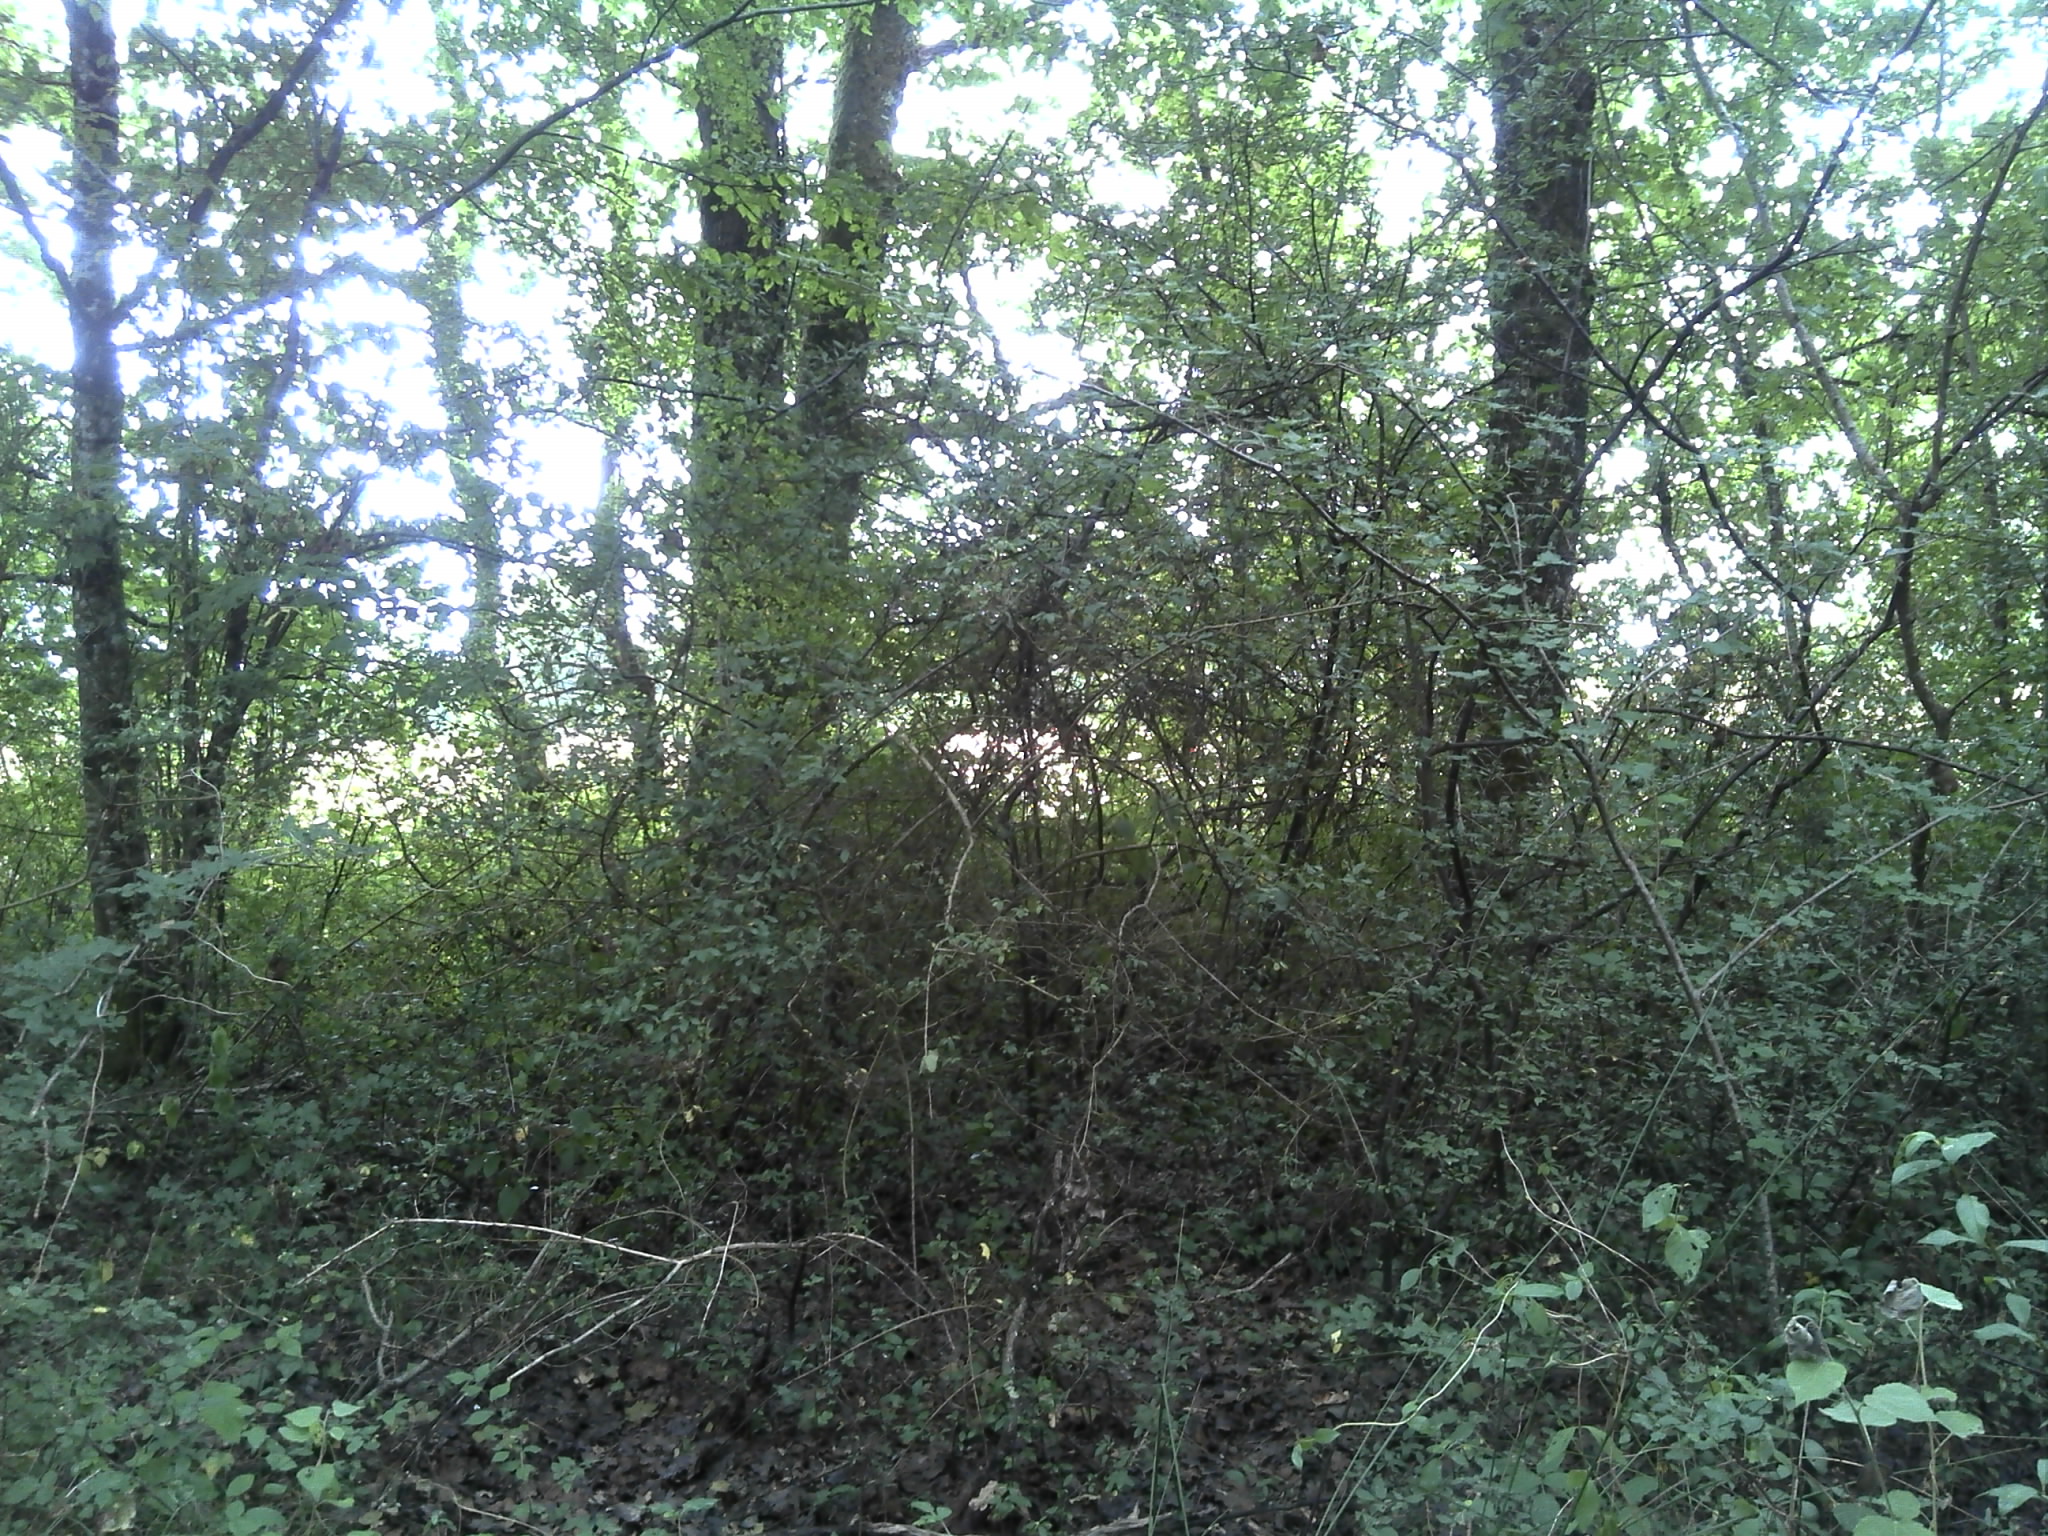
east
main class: Woodland
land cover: Broadleaved woodland
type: mesophytic deciduous forest
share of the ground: > 75 %
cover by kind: broadleaved forest trees 85 %, shrubs 10 %, herbaceous plants 5 %
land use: Forestry
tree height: > 5 m
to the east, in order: Broadleaved woodland; Ditches and canals; Grassland without tree/shrub cover; Abandoned hedges; Ditches and canals; Grassland without tree/shrub cover; Broadleaved woodland; Ditches and canals; Grass margins; Tracks; Grass margins; Fences; Broadleaved woodland; Fences; Grassland without tree/shrub cover; Electric lines; Ditches and canals; Grass margins; Paved roads, cycling and walking lanes
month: July
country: FR
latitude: 46.7520
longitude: 1.4664
